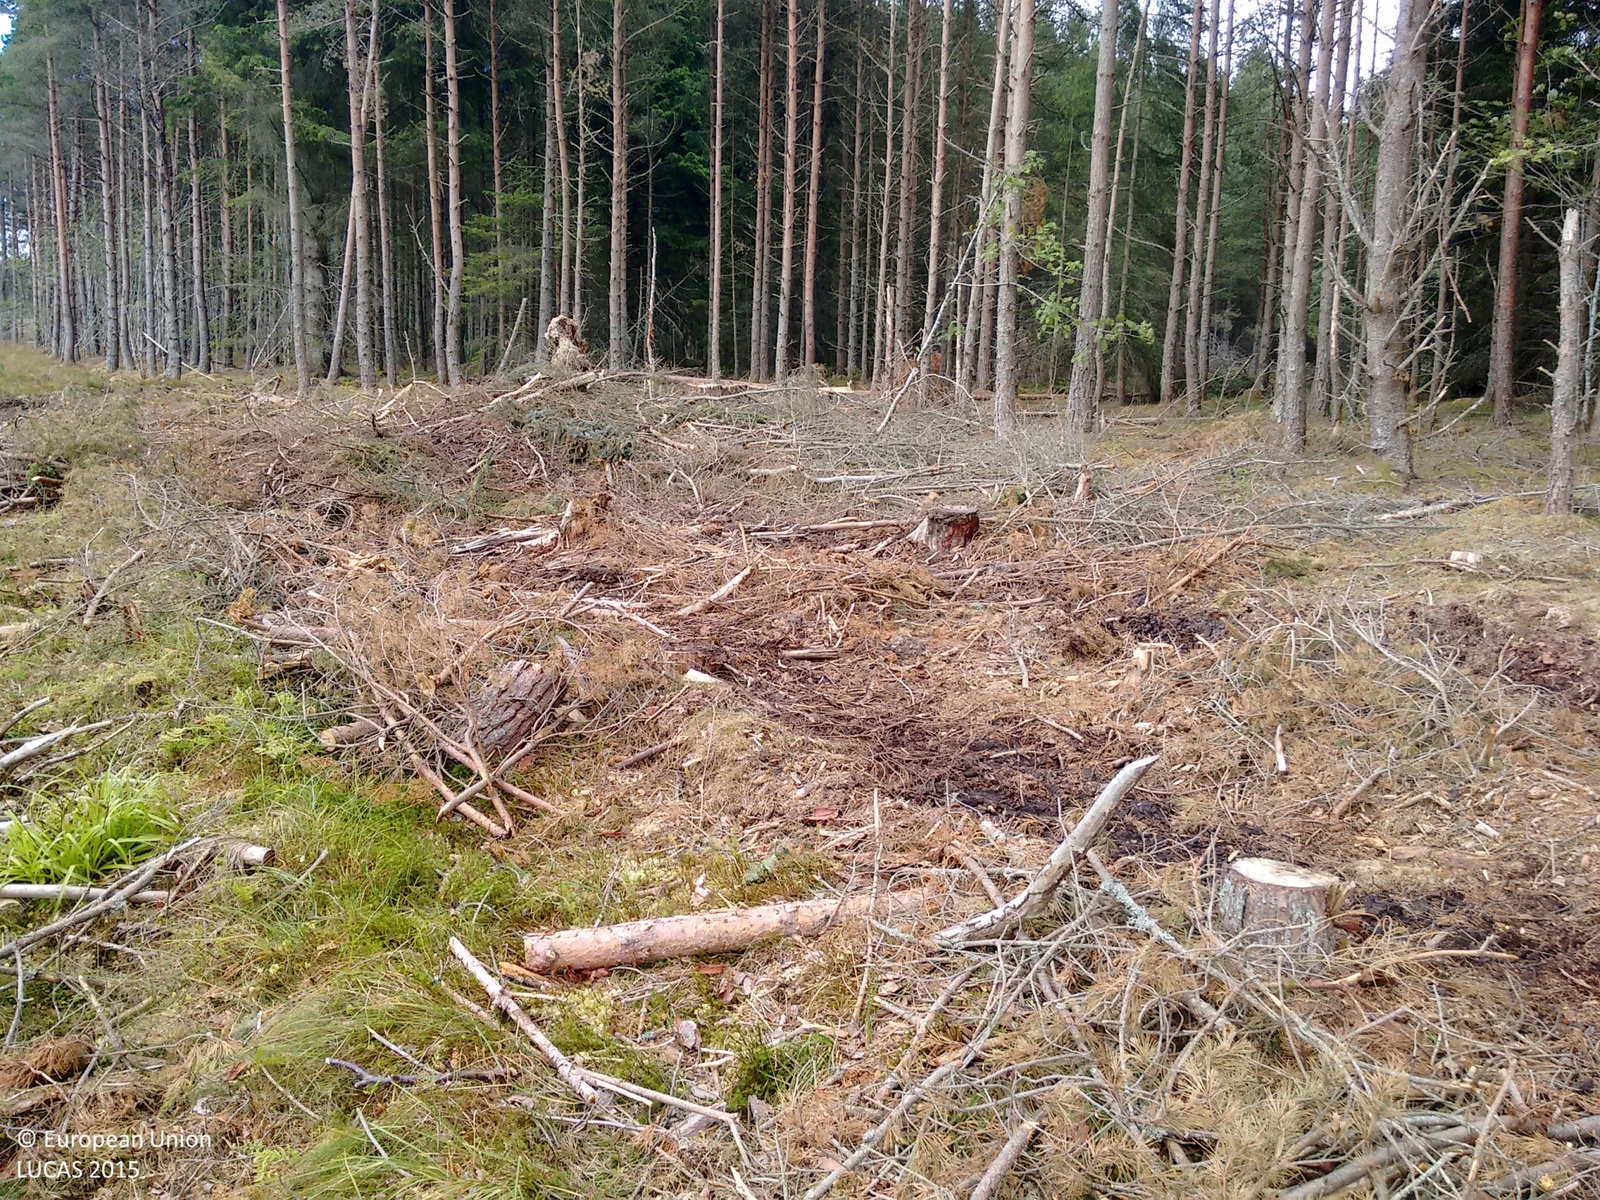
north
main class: Grassland
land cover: Grassland with sparse tree/shrub cover
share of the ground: > 75 %
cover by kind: herbaceous plants 50 %, lichens and mosses 25 %, unconsolidated bare surface 20 %, broadleaved forest trees 5 %
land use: Forestry
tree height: > 5 m
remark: Clear cut
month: August
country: GB
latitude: 57.6514
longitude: -2.8771
